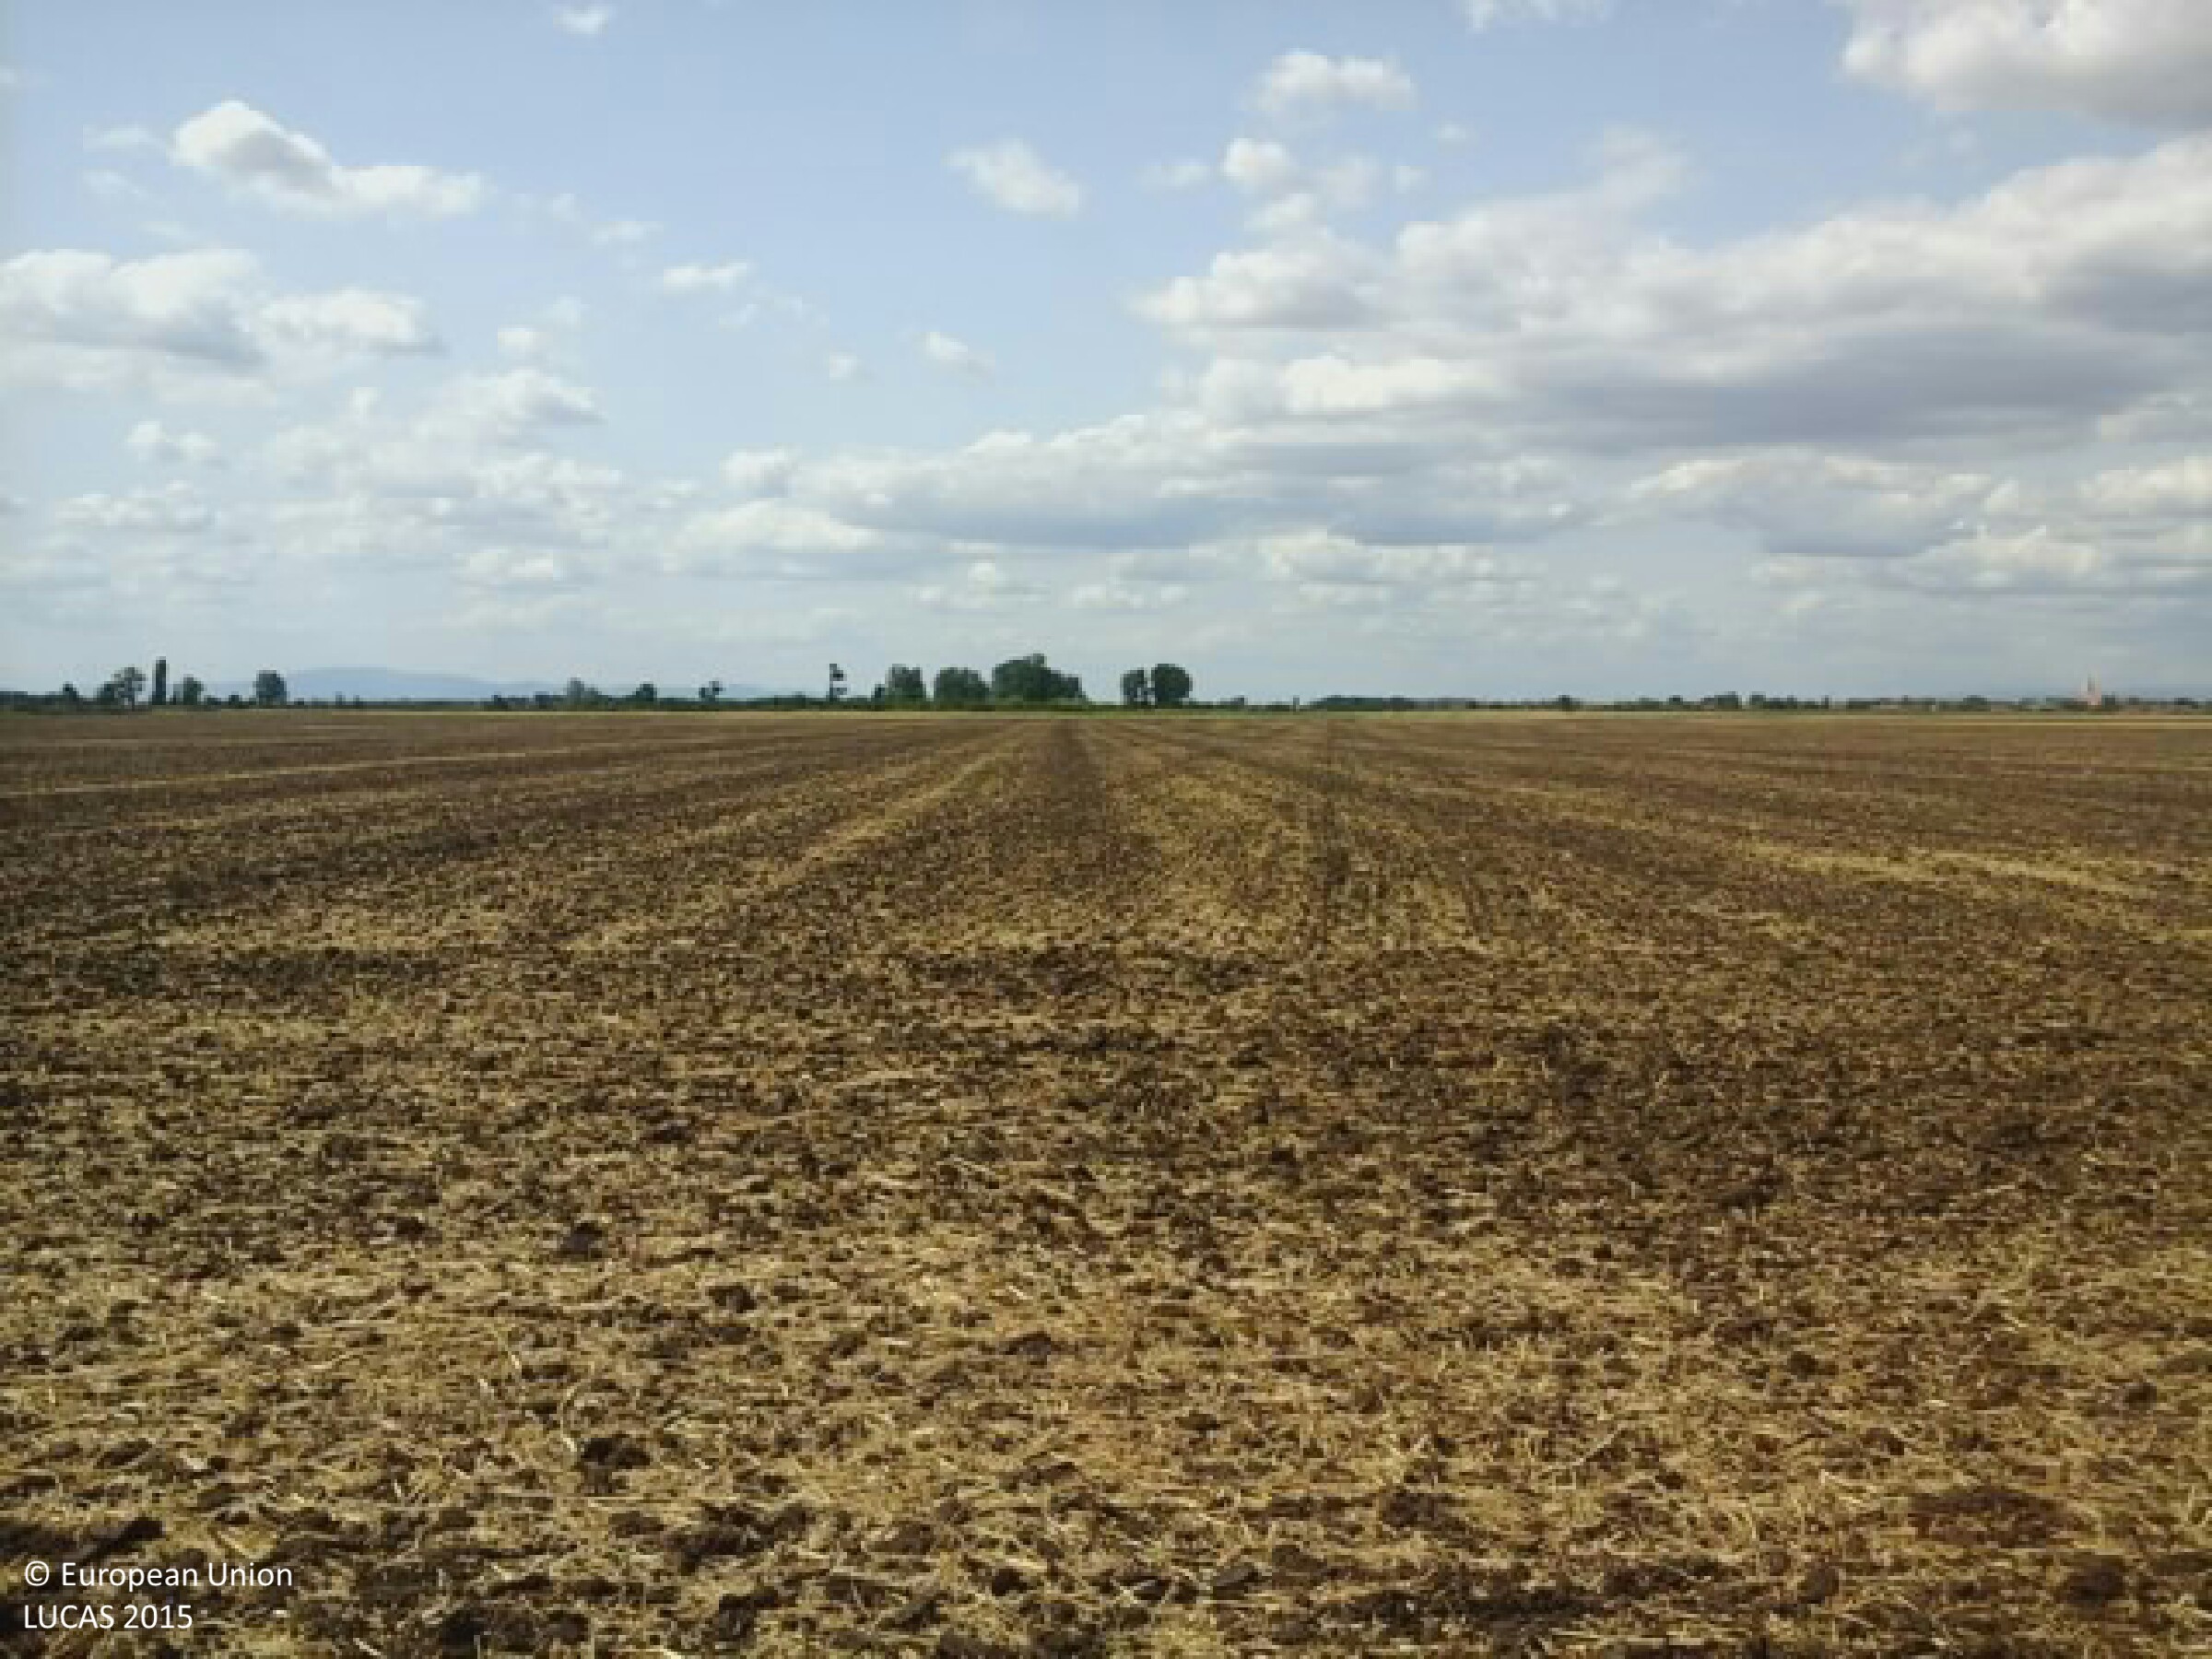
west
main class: Cropland
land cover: Common wheat
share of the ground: < 10 %
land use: Agriculture (excluding fallow land and kitchen gardens)
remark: Harvested field
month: July
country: HU
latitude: 47.5812
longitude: 20.4413
